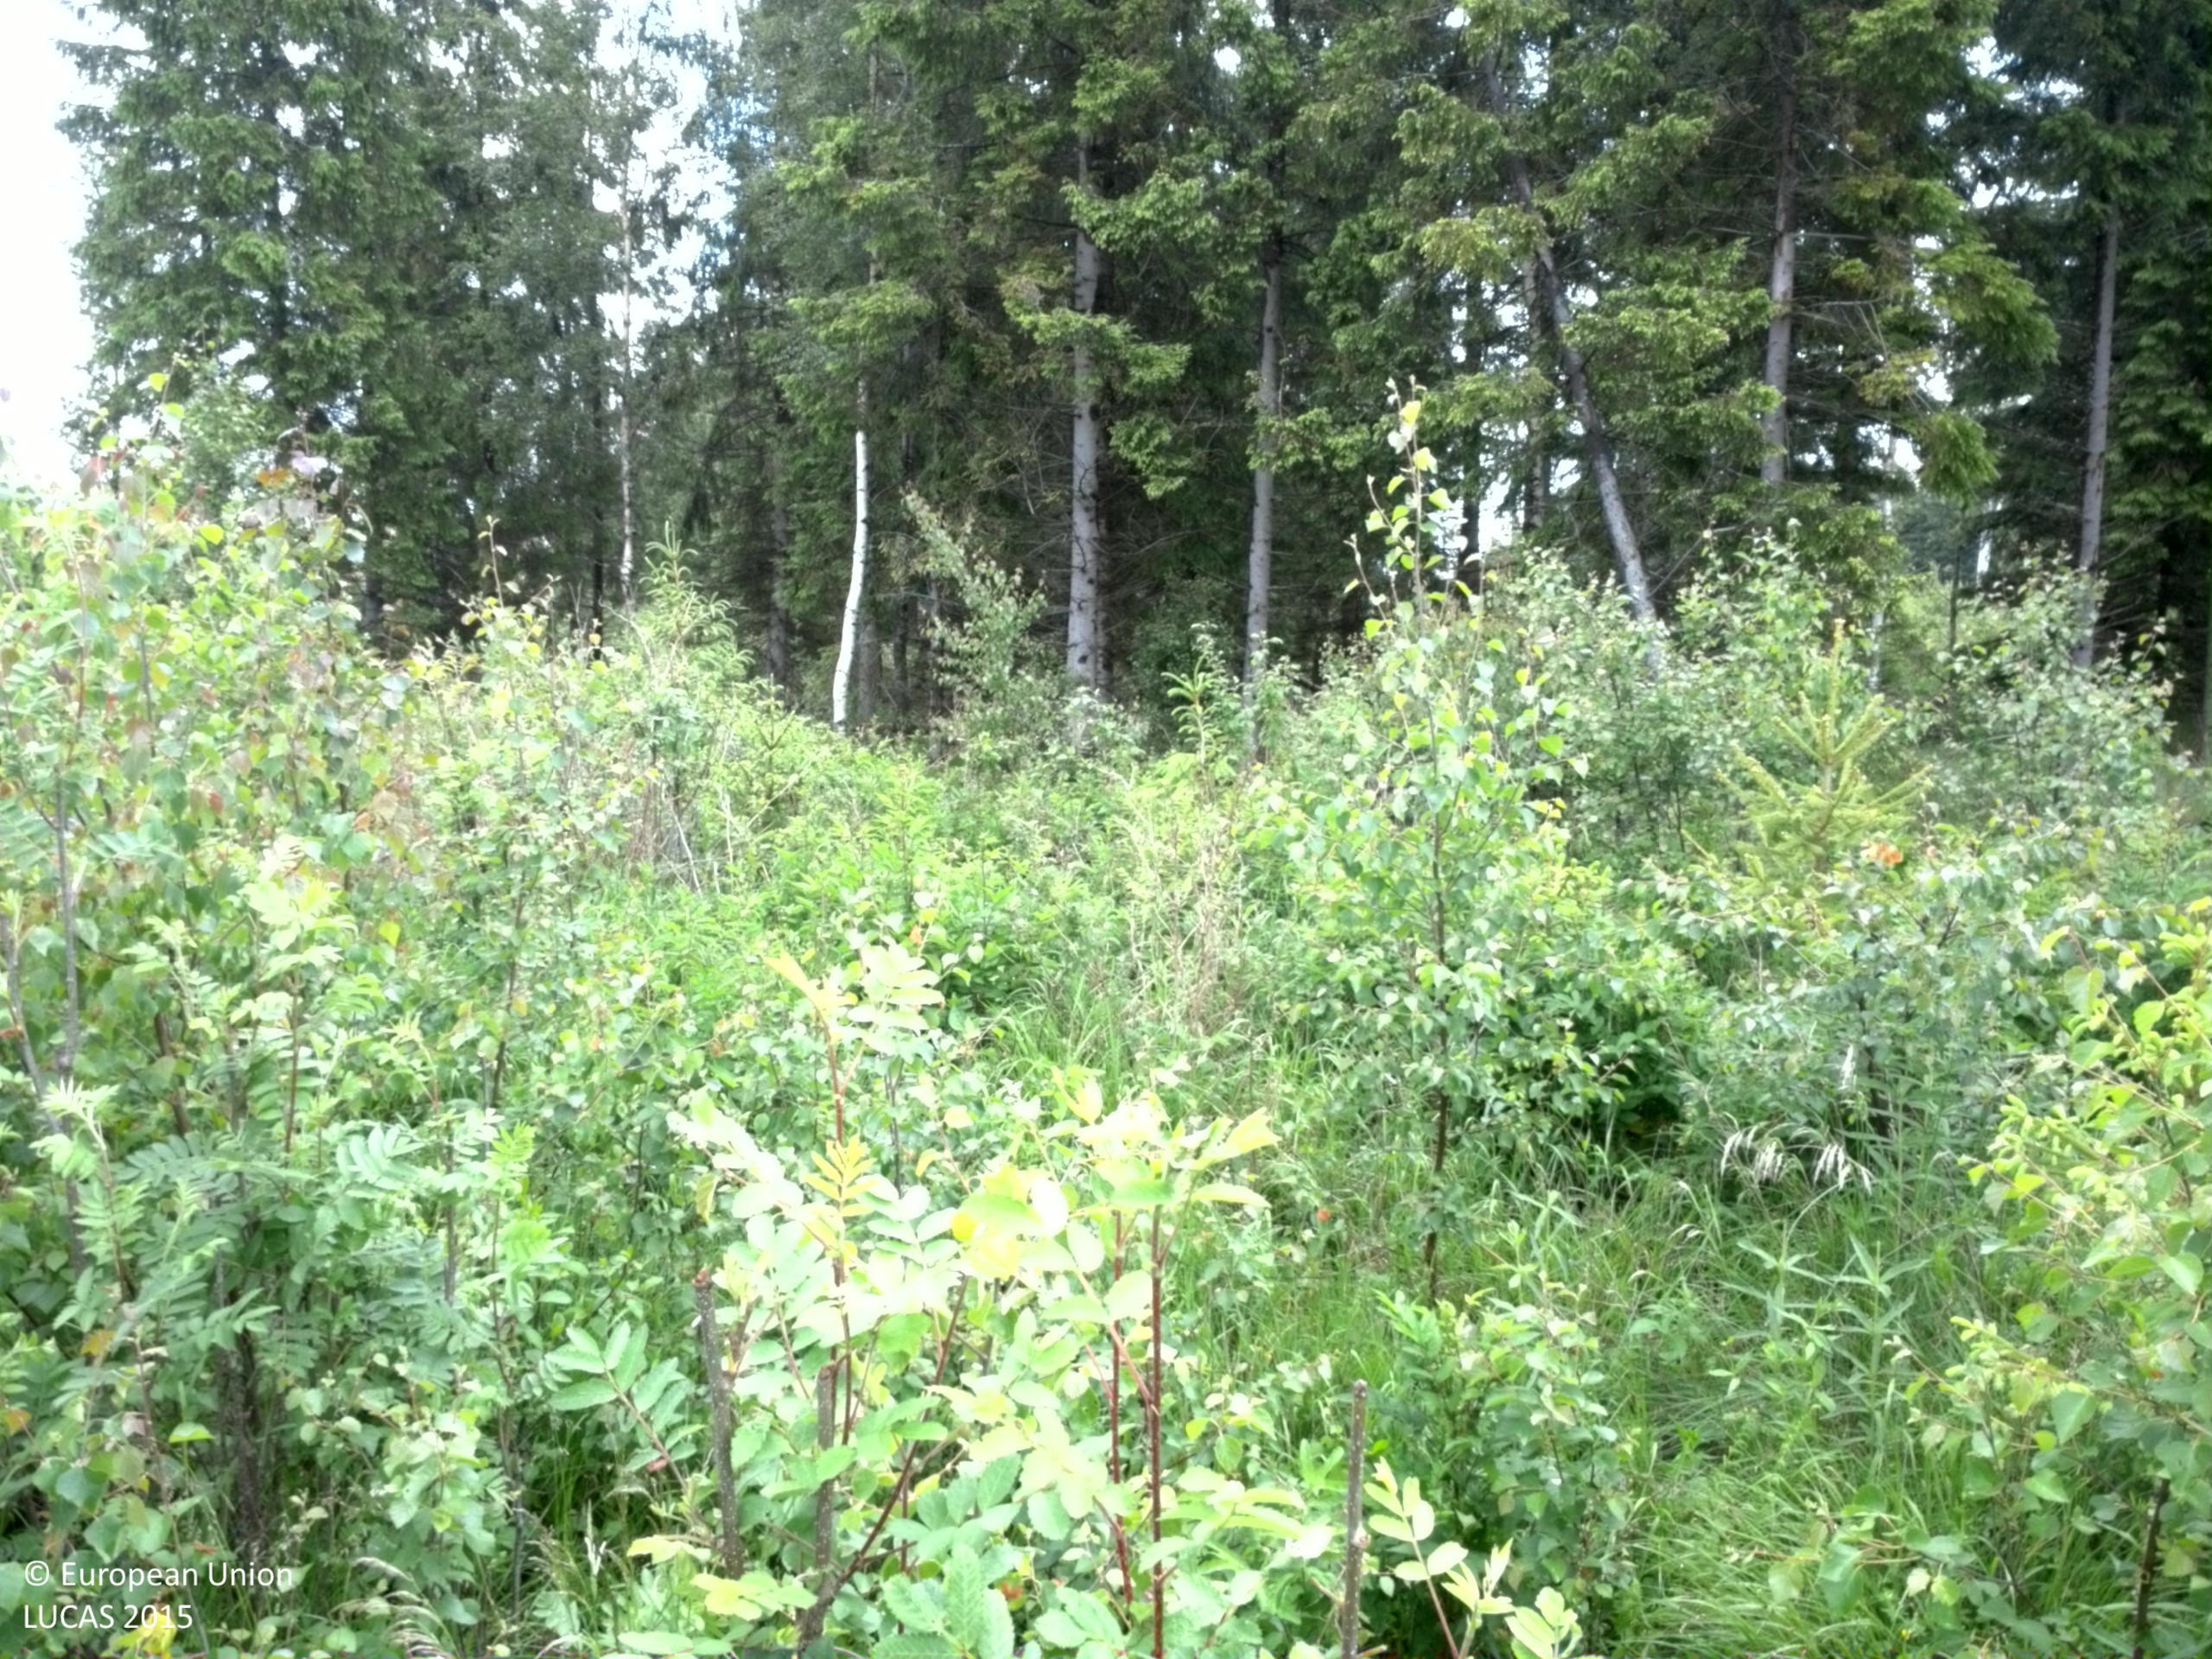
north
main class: Woodland
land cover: Broadleaved woodland
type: boreal forest
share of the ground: 25 - 50 %
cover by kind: broadleaved forest trees 45 %, herbaceous plants 30 %, shrubs 15 %, coniferous forest trees 5 %
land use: Forestry
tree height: < 5 m
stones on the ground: < 10 %
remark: Clear cut
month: June
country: SE
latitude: 60.3028
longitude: 17.5742
